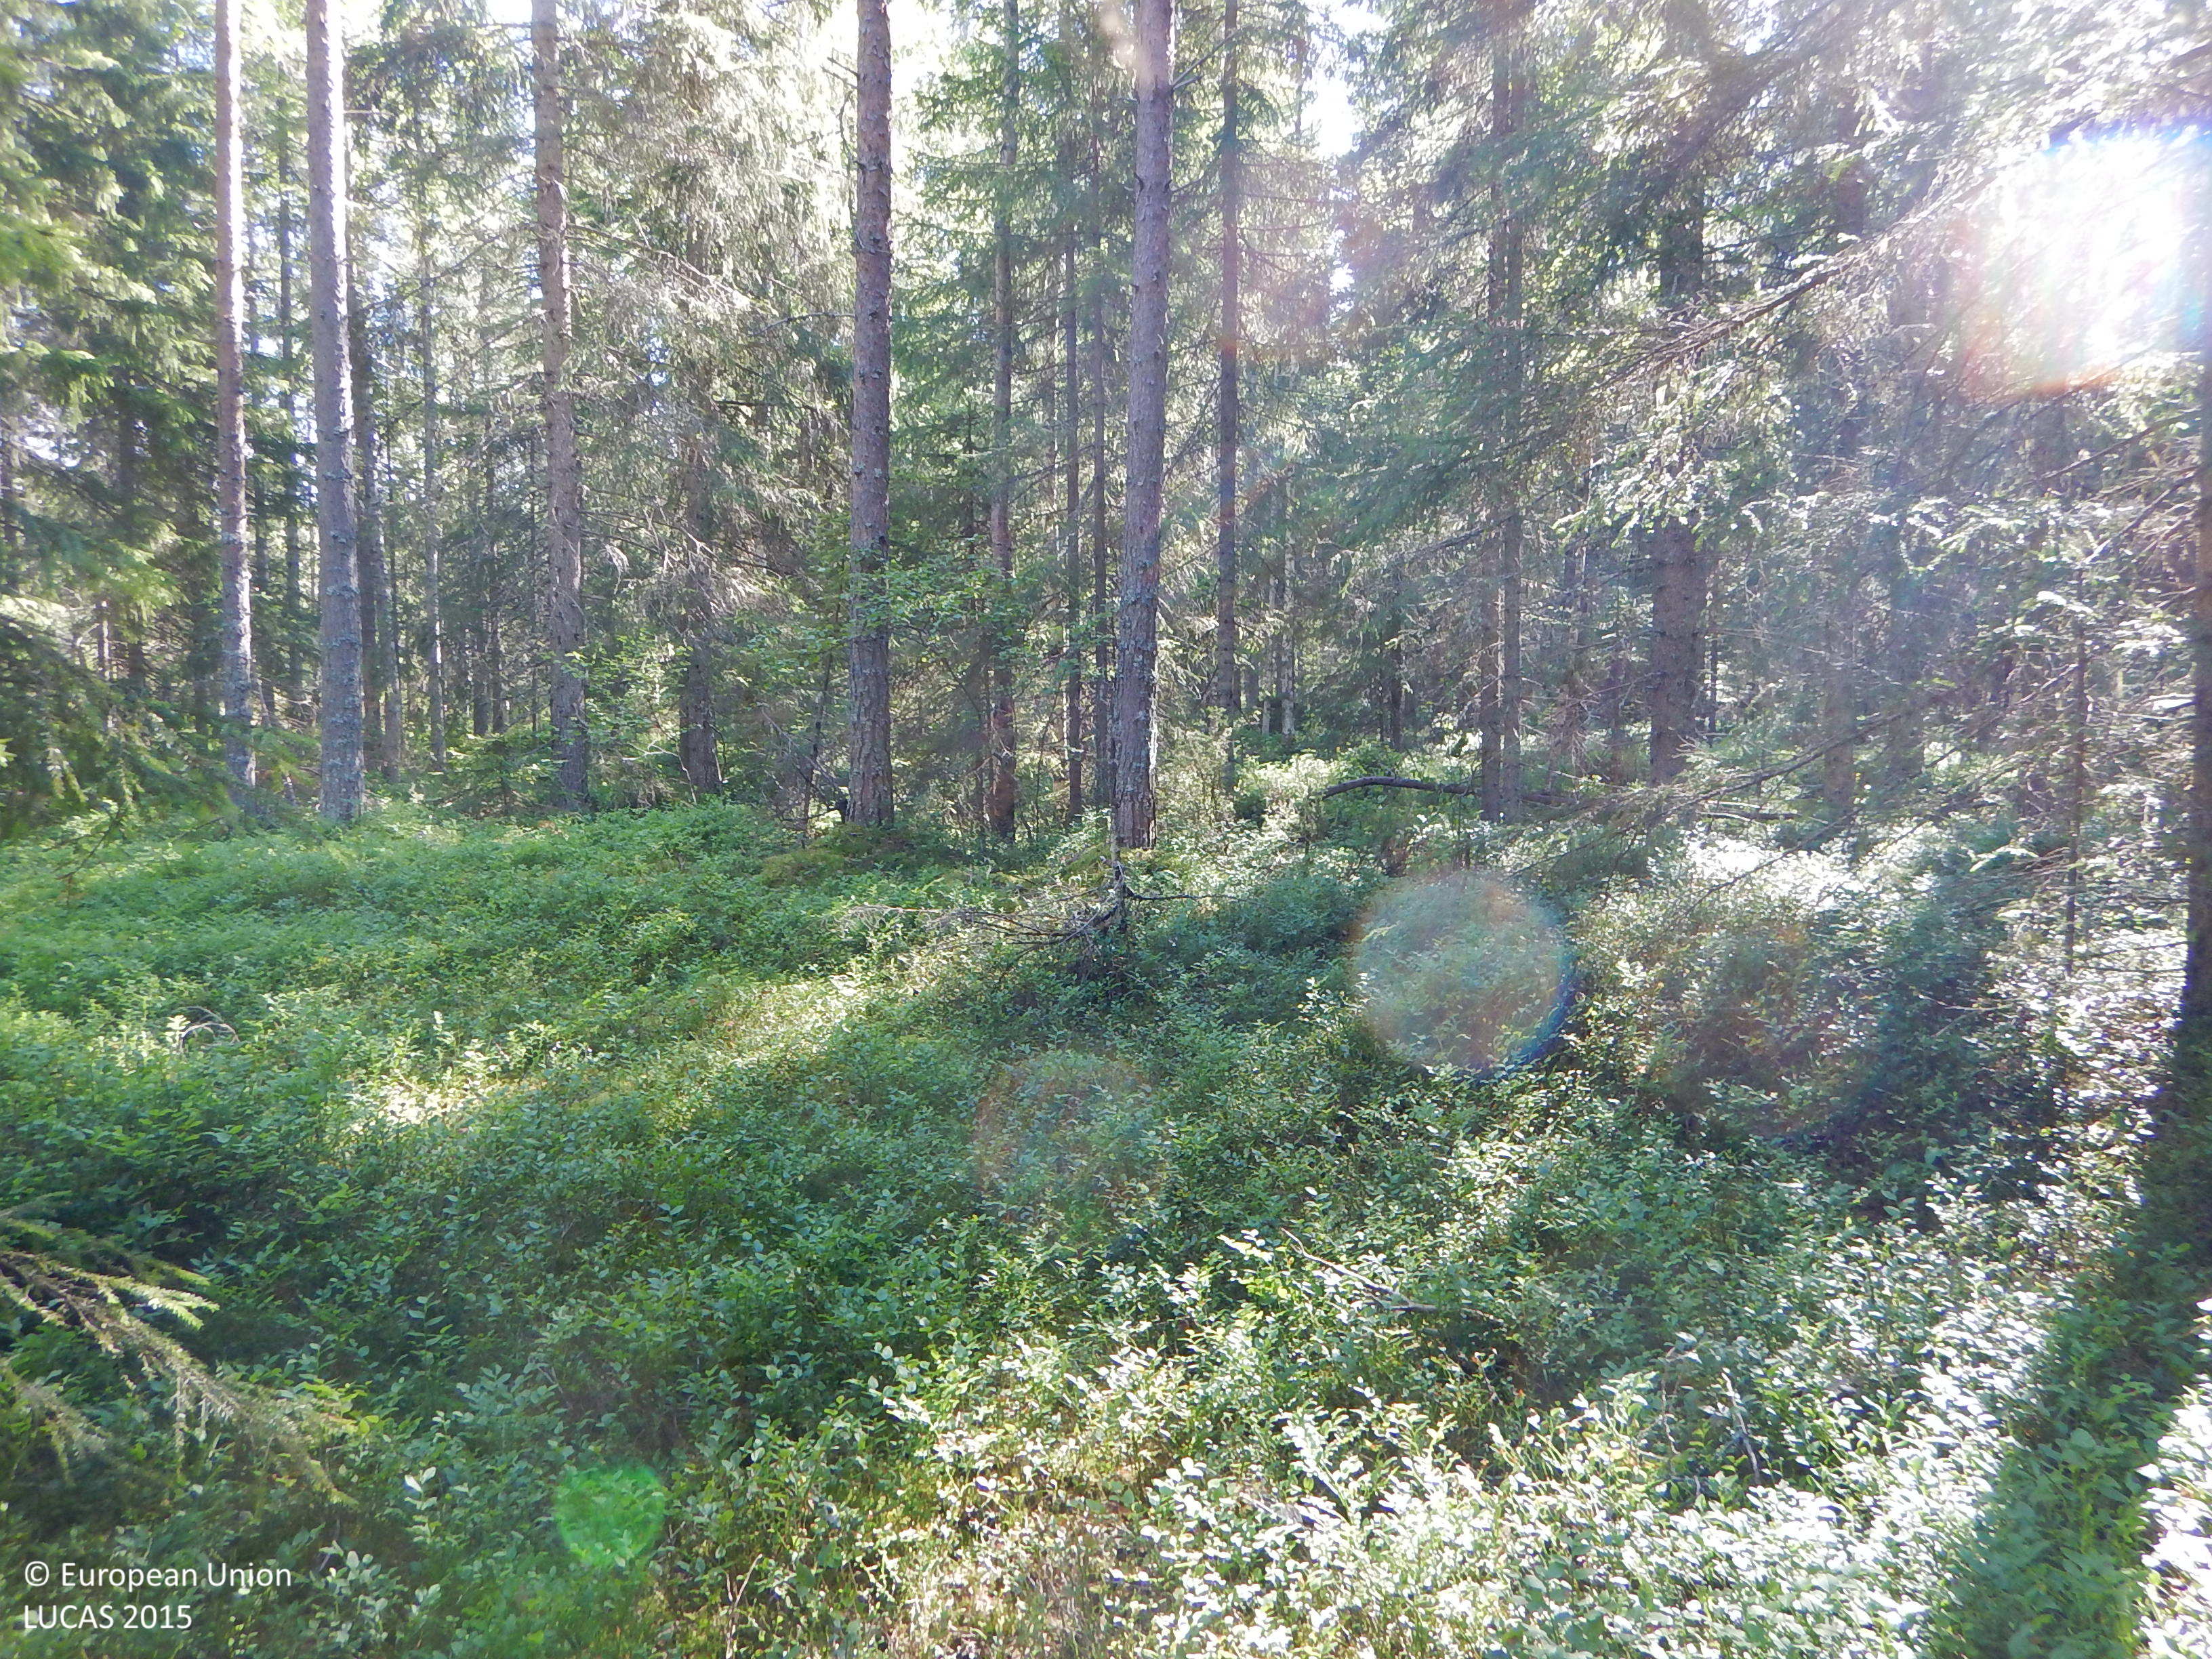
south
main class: Woodland
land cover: Spruce dominated mixed woodland
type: boreal forest
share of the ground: 50 - 75 %
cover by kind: coniferous forest trees 50 %, broadleaved forest trees 20 %, shrubs 15 %, herbaceous plants 10 %, lichens and mosses 5 %
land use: Forestry
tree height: > 5 m
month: July
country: SE
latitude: 64.8221
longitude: 20.9530
